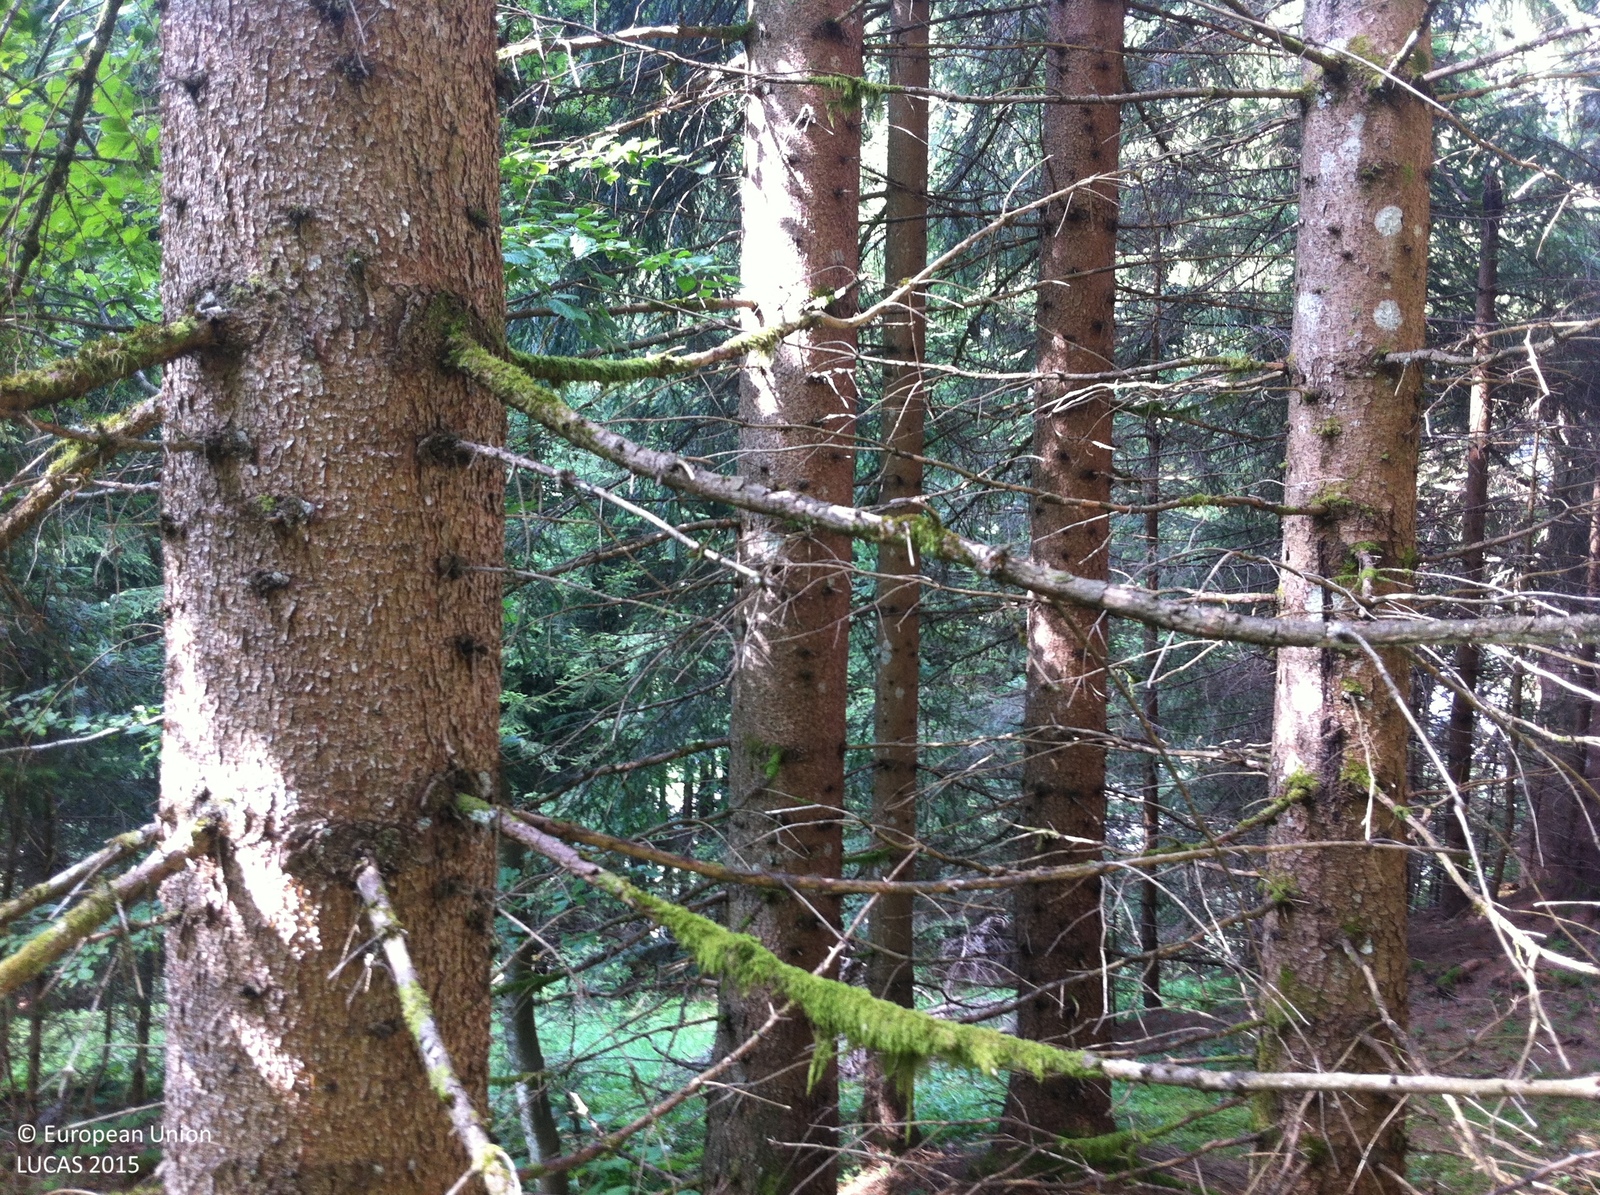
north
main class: Woodland
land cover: Spruce dominated coniferous woodland
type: alpine coniferous forest
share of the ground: > 75 %
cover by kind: coniferous forest trees 85 %, broadleaved forest trees 5 %, shrubs 5 %, herbaceous plants 5 %
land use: Forestry
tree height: > 5 m
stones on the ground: < 10 %
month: July
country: AT
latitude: 47.1255
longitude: 10.0395
